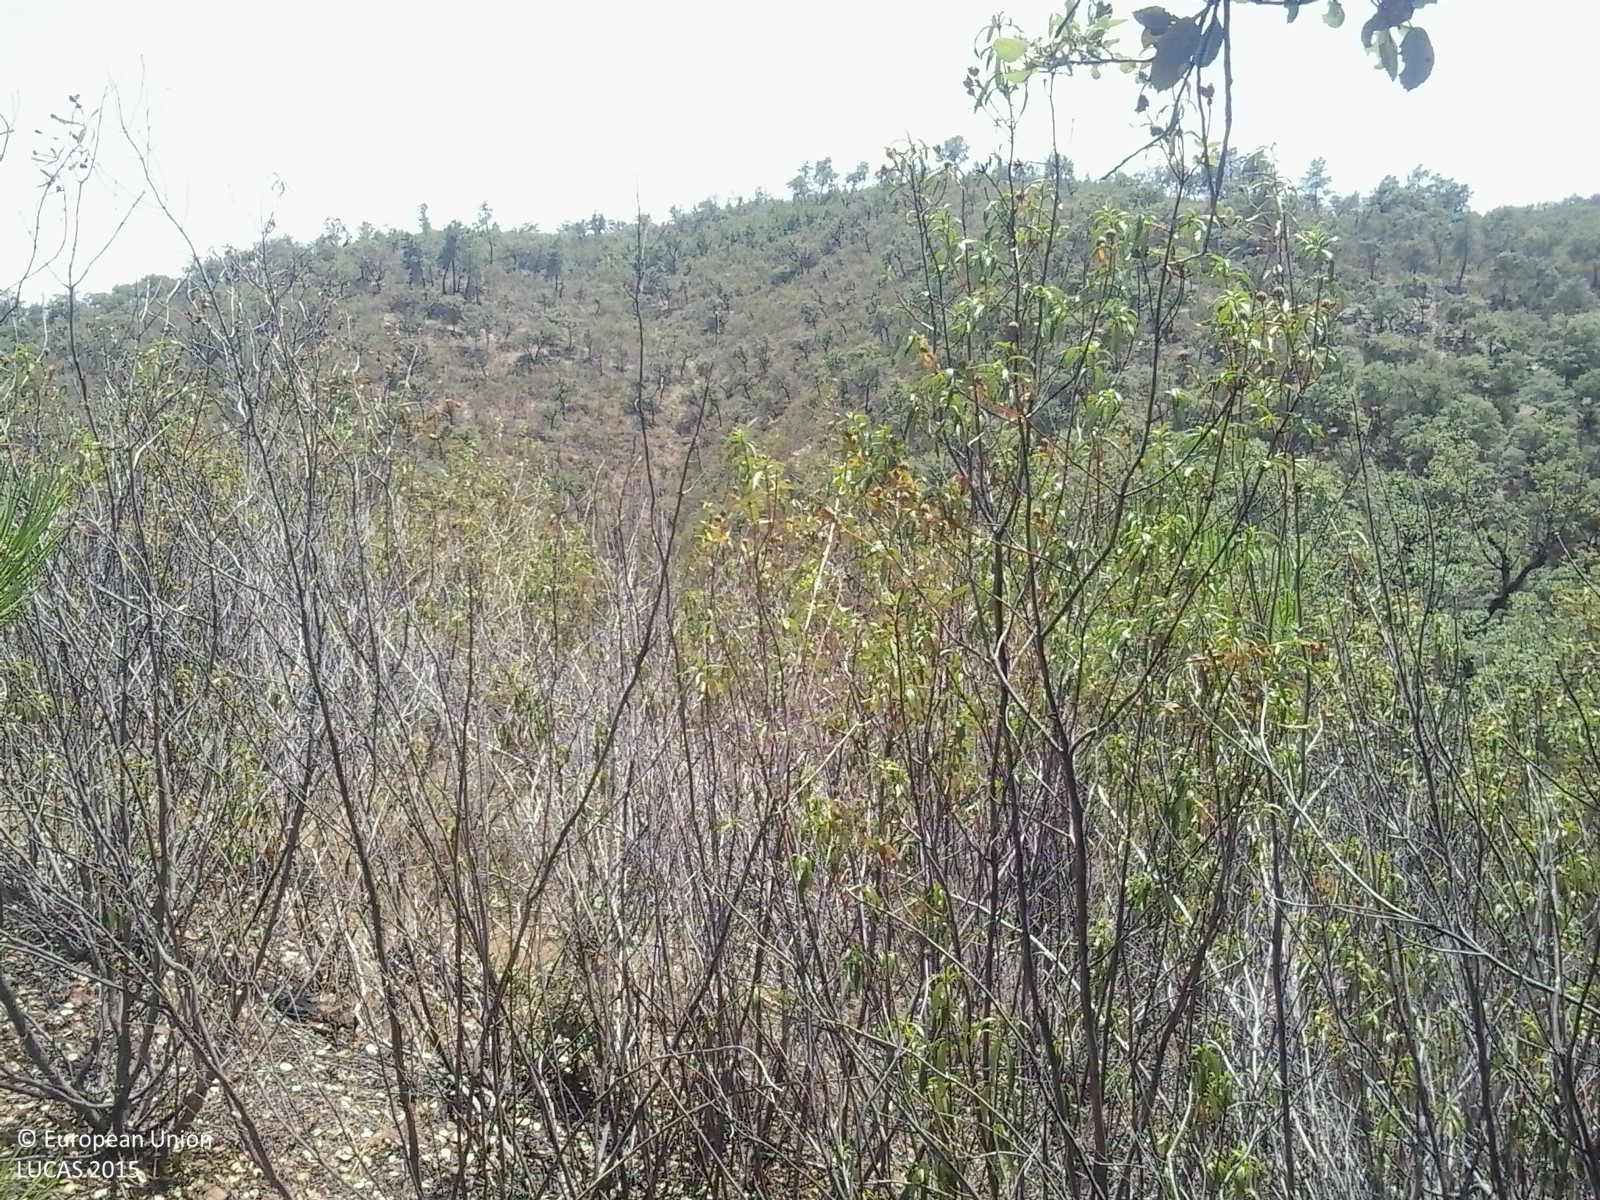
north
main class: Shrubland
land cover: Shrubland with sparse tree cover
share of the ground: > 75 %
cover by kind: shrubs 85 %, herbaceous plants 10 %, broadleaved forest trees 5 %
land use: Forestry
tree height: < 5 m
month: July
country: ES
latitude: 37.5651
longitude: -6.4164
